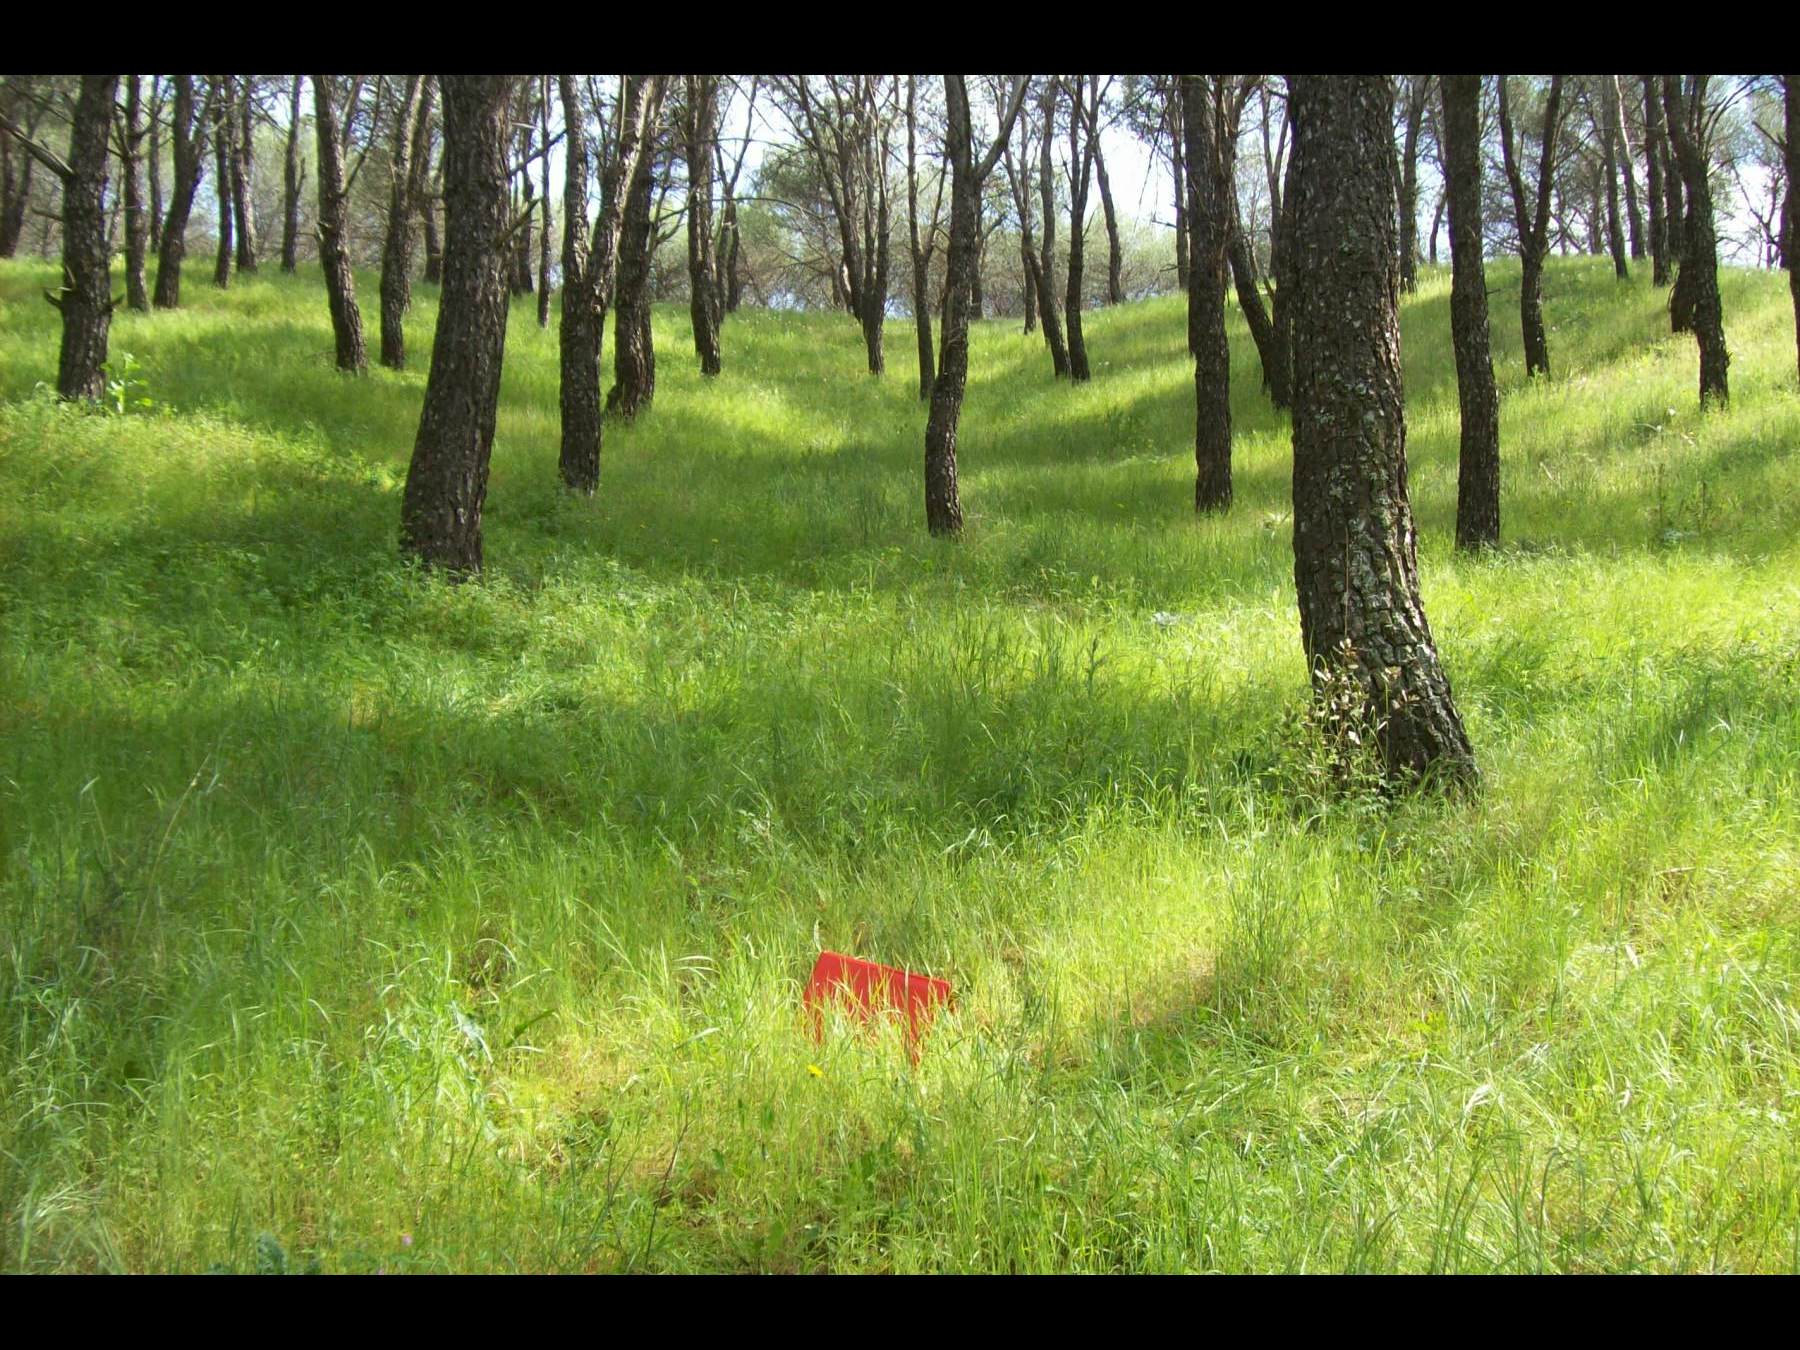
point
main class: Woodland
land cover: Pine dominated coniferous woodland
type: coniferous forest of the mediterranean region
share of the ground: > 75 %
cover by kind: coniferous forest trees 90 %, herbaceous plants 10 %
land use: Amenities, museums, leisure
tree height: > 5 m
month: April
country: ES
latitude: 40.5192
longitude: -3.7668
